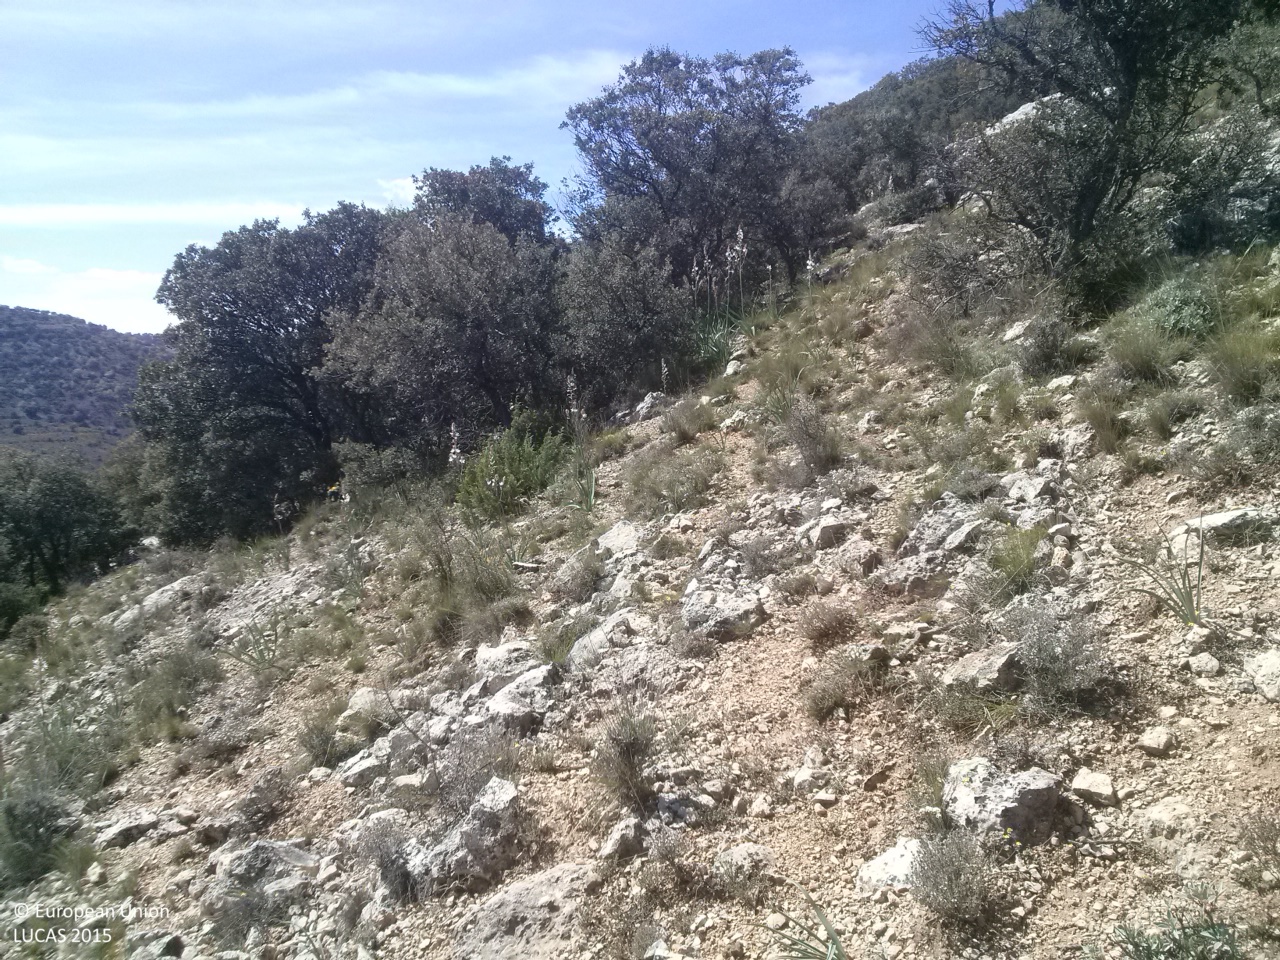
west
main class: Woodland
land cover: Broadleaved woodland
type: broadleaved evergreen forest
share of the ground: 25 - 50 %
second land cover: Grassland without tree/shrub cover
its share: 25 - 50 %
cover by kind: broadleaved forest trees 40 %, herbaceous plants 30 %, unconsolidated bare surface 25 %, shrubs 5 %
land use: Forestry
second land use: Agriculture (excluding fallow land and kitchen gardens)
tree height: < 5 m
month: April
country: ES
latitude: 40.0661
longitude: -1.6305
